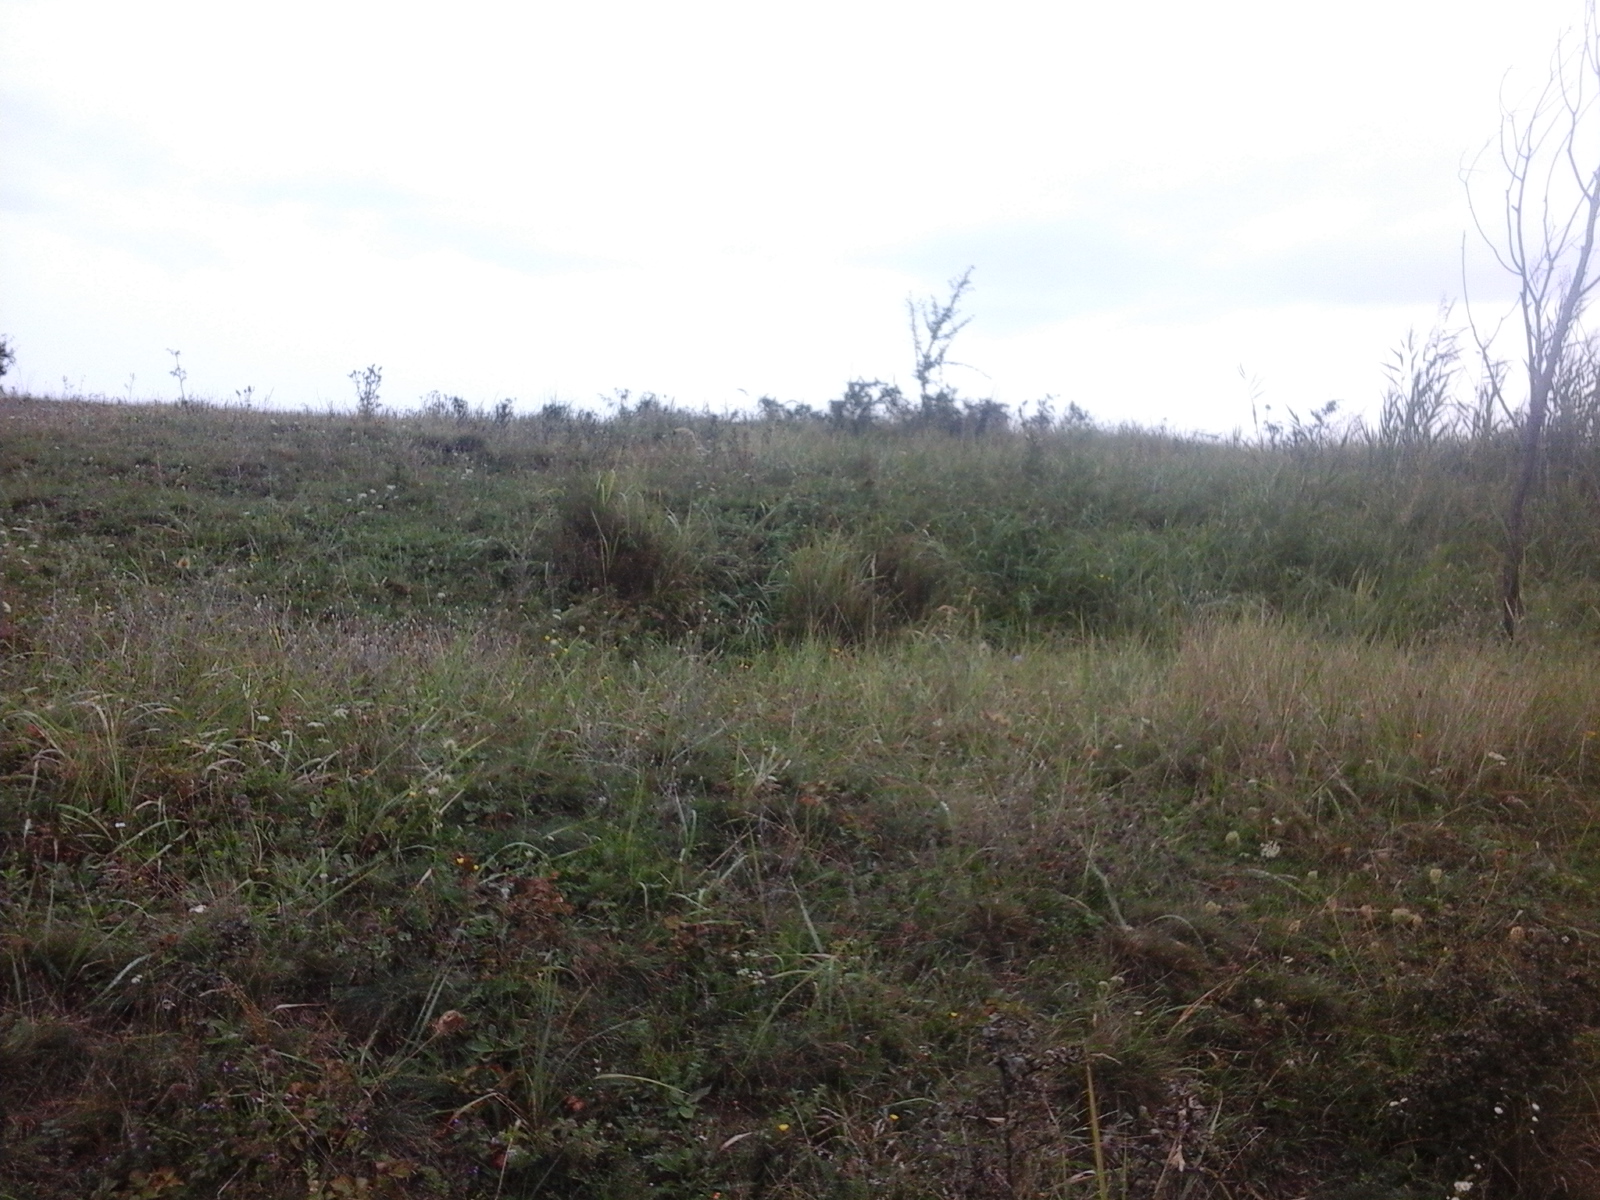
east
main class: Grassland
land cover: Grassland without tree/shrub cover
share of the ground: > 75 %
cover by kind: herbaceous plants 100 %
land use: Agriculture (excluding fallow land and kitchen gardens)
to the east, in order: Grassland without tree/shrub cover; Tracks; Grassland without tree/shrub cover; Common wheat
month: September
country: RO
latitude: 47.3137
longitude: 22.6117
